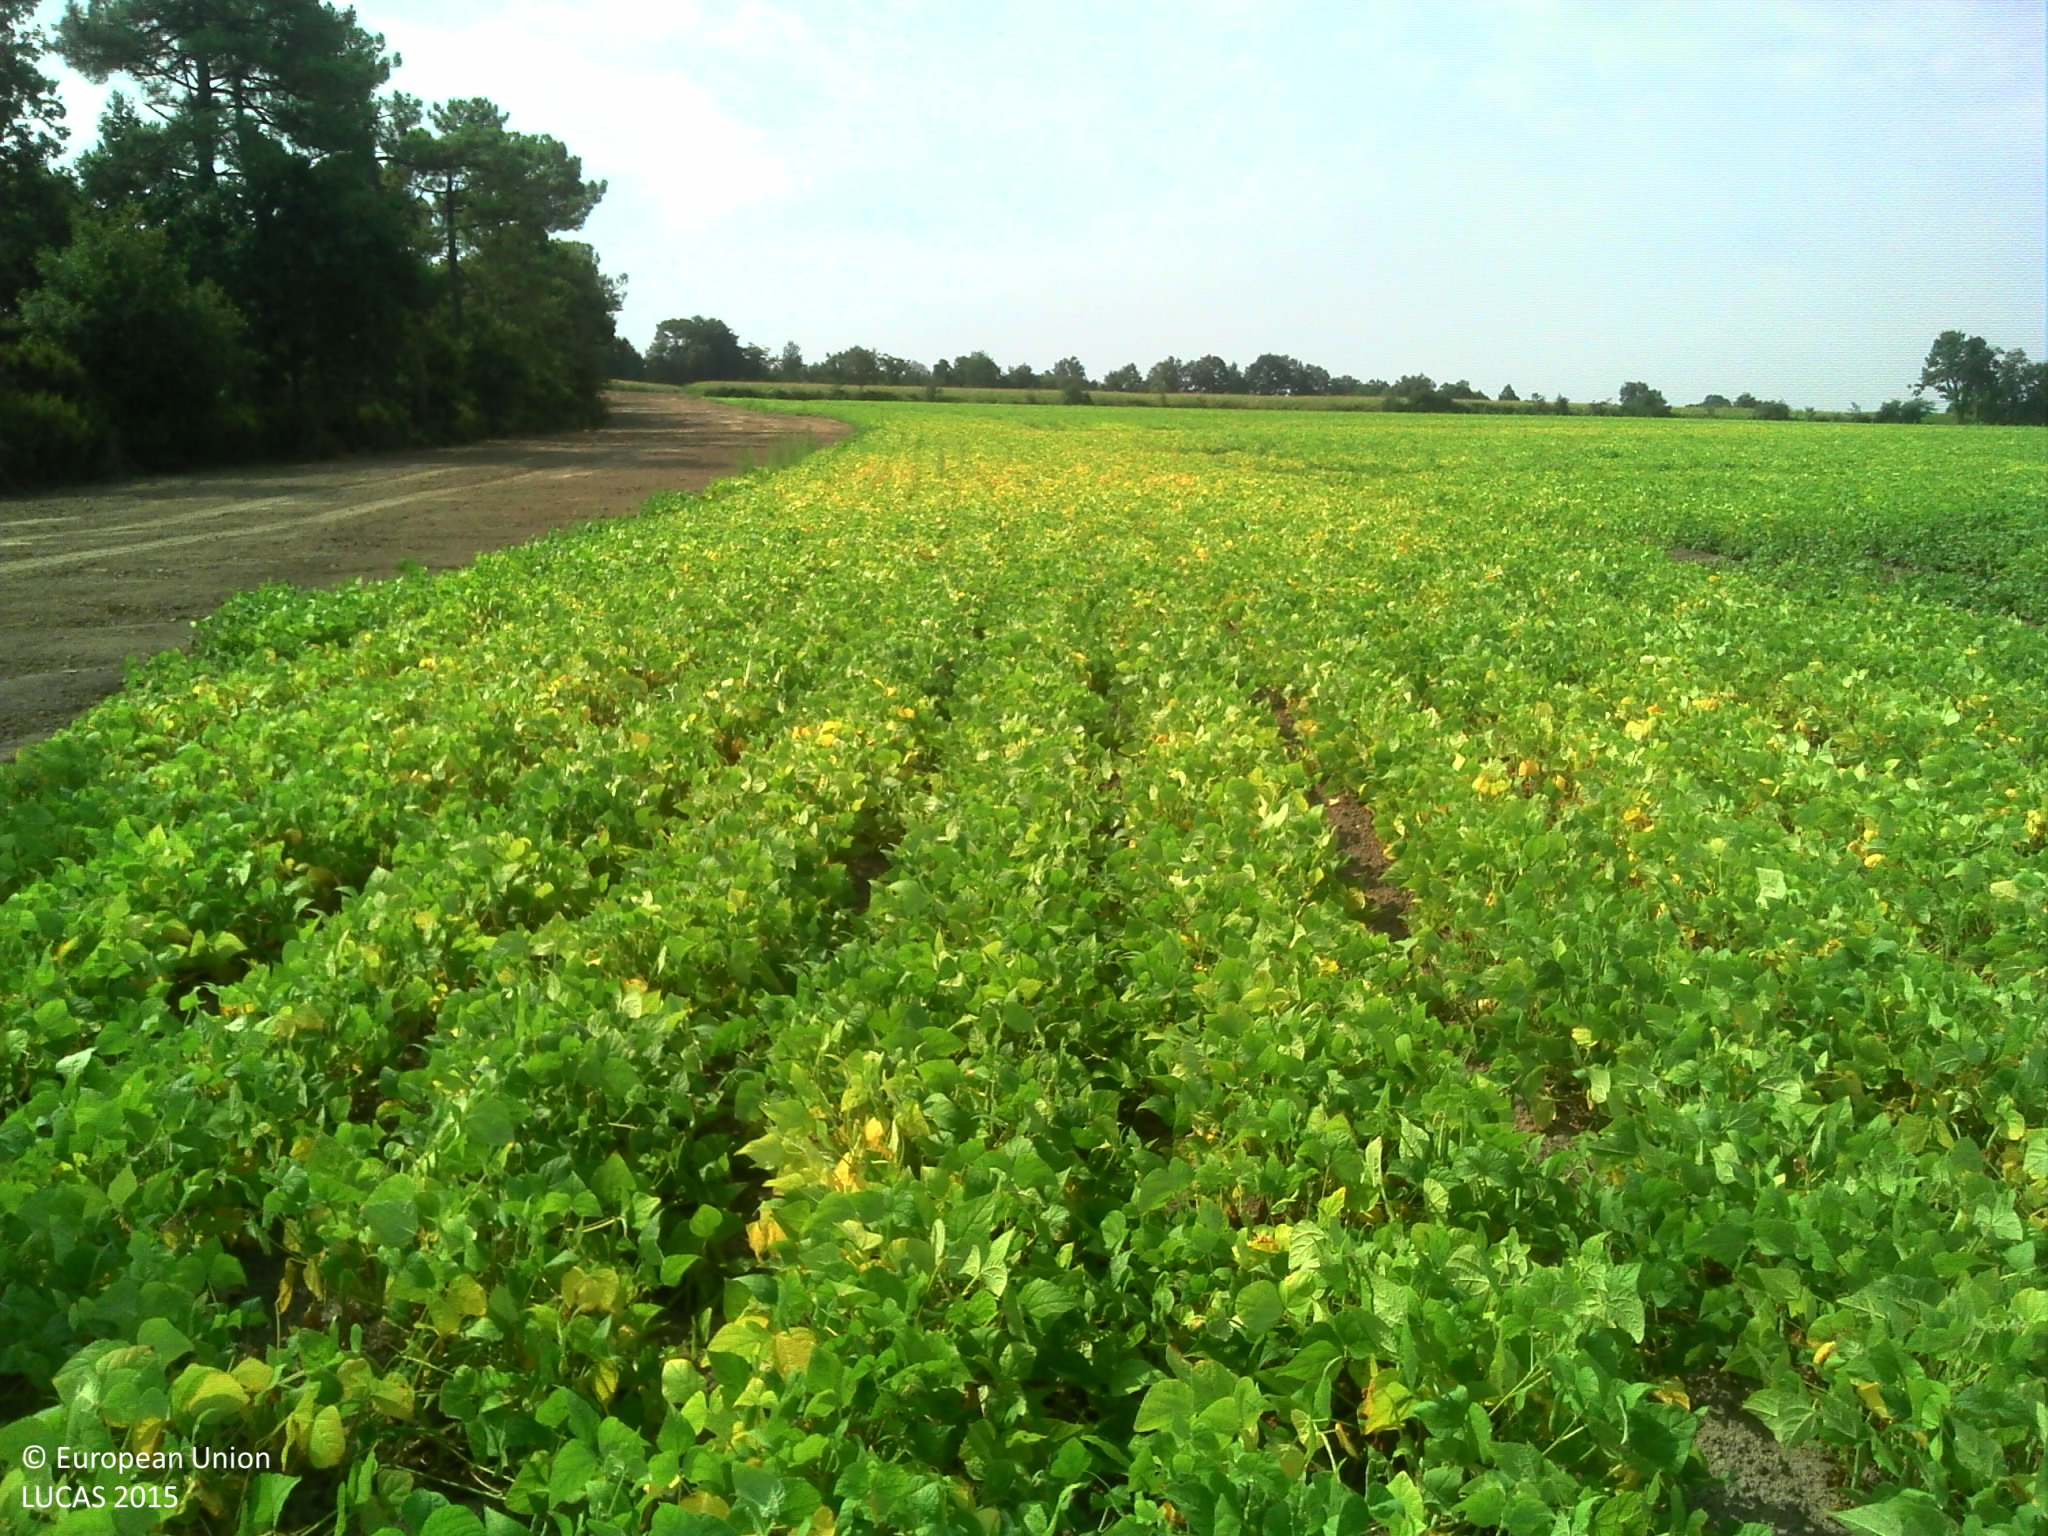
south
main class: Cropland
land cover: Dry pulses
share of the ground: > 75 %
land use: Agriculture (excluding fallow land and kitchen gardens)
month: August
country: FR
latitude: 46.7047
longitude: -1.7216
